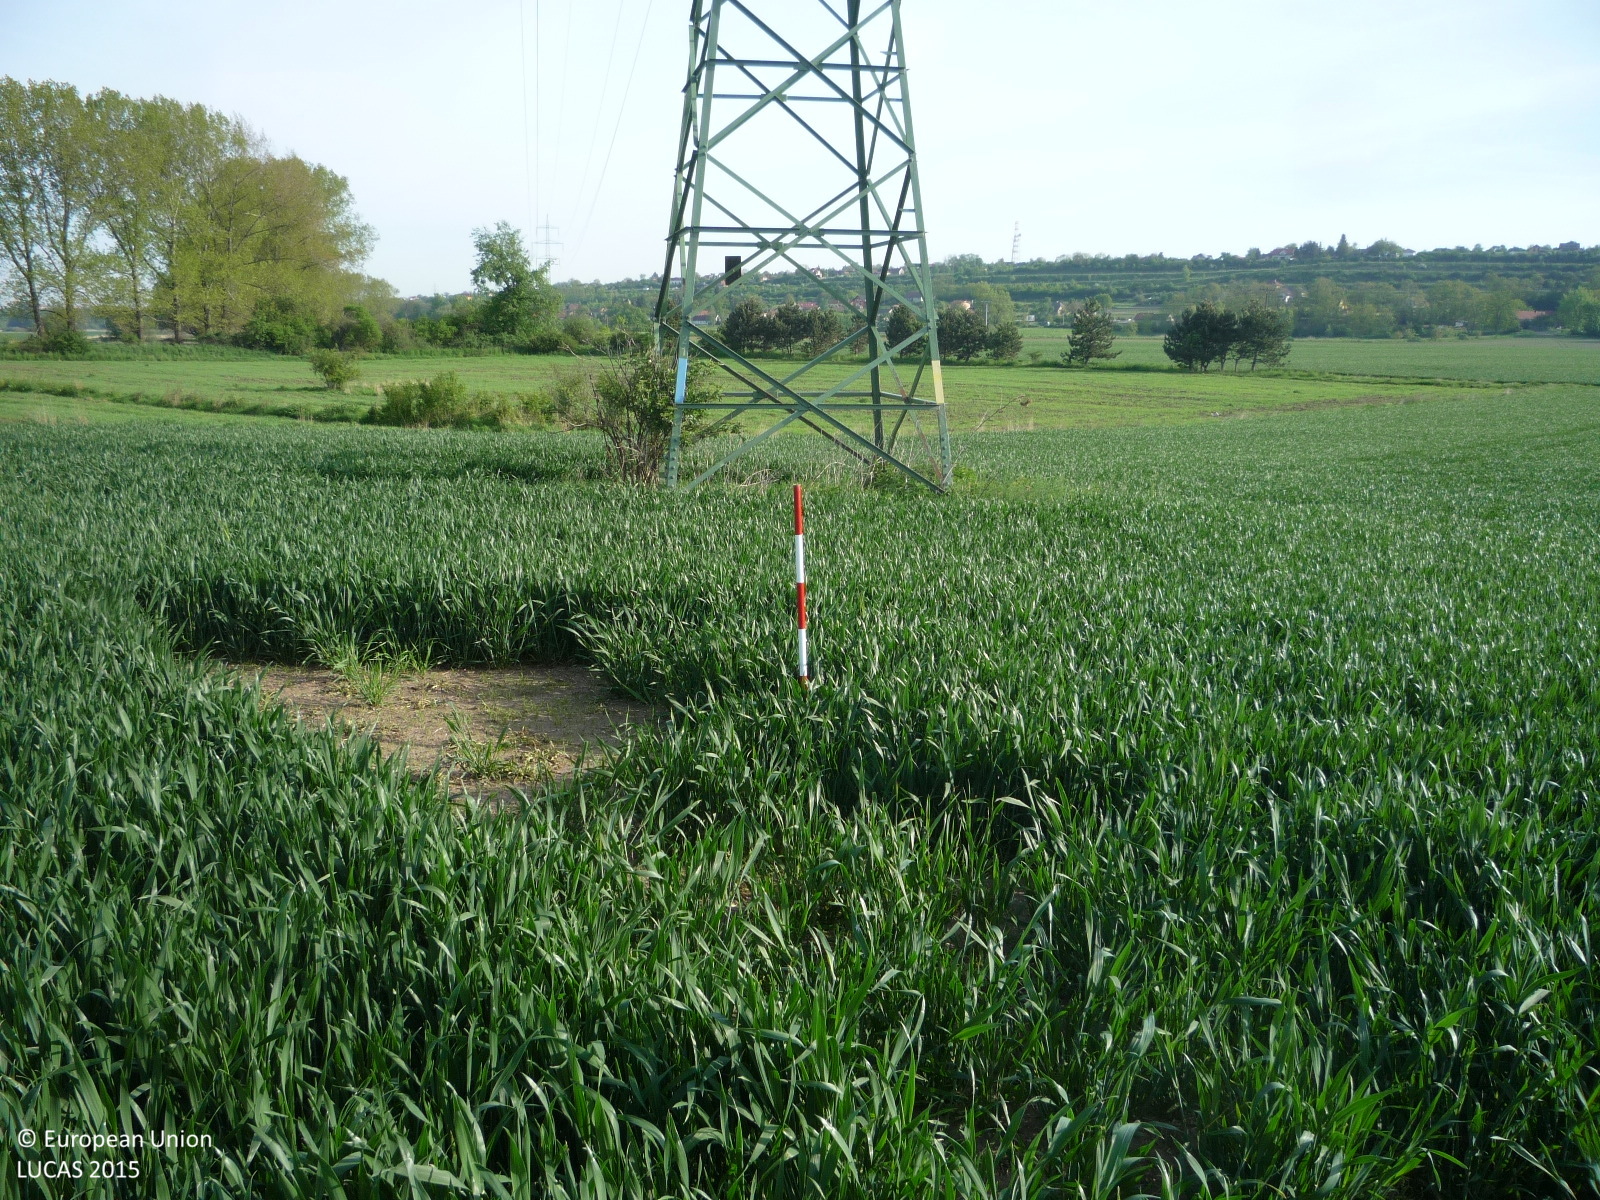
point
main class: Cropland
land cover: Common wheat
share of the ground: > 75 %
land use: Agriculture (excluding fallow land and kitchen gardens)
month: May
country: CZ
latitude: 50.3112
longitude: 14.5093
